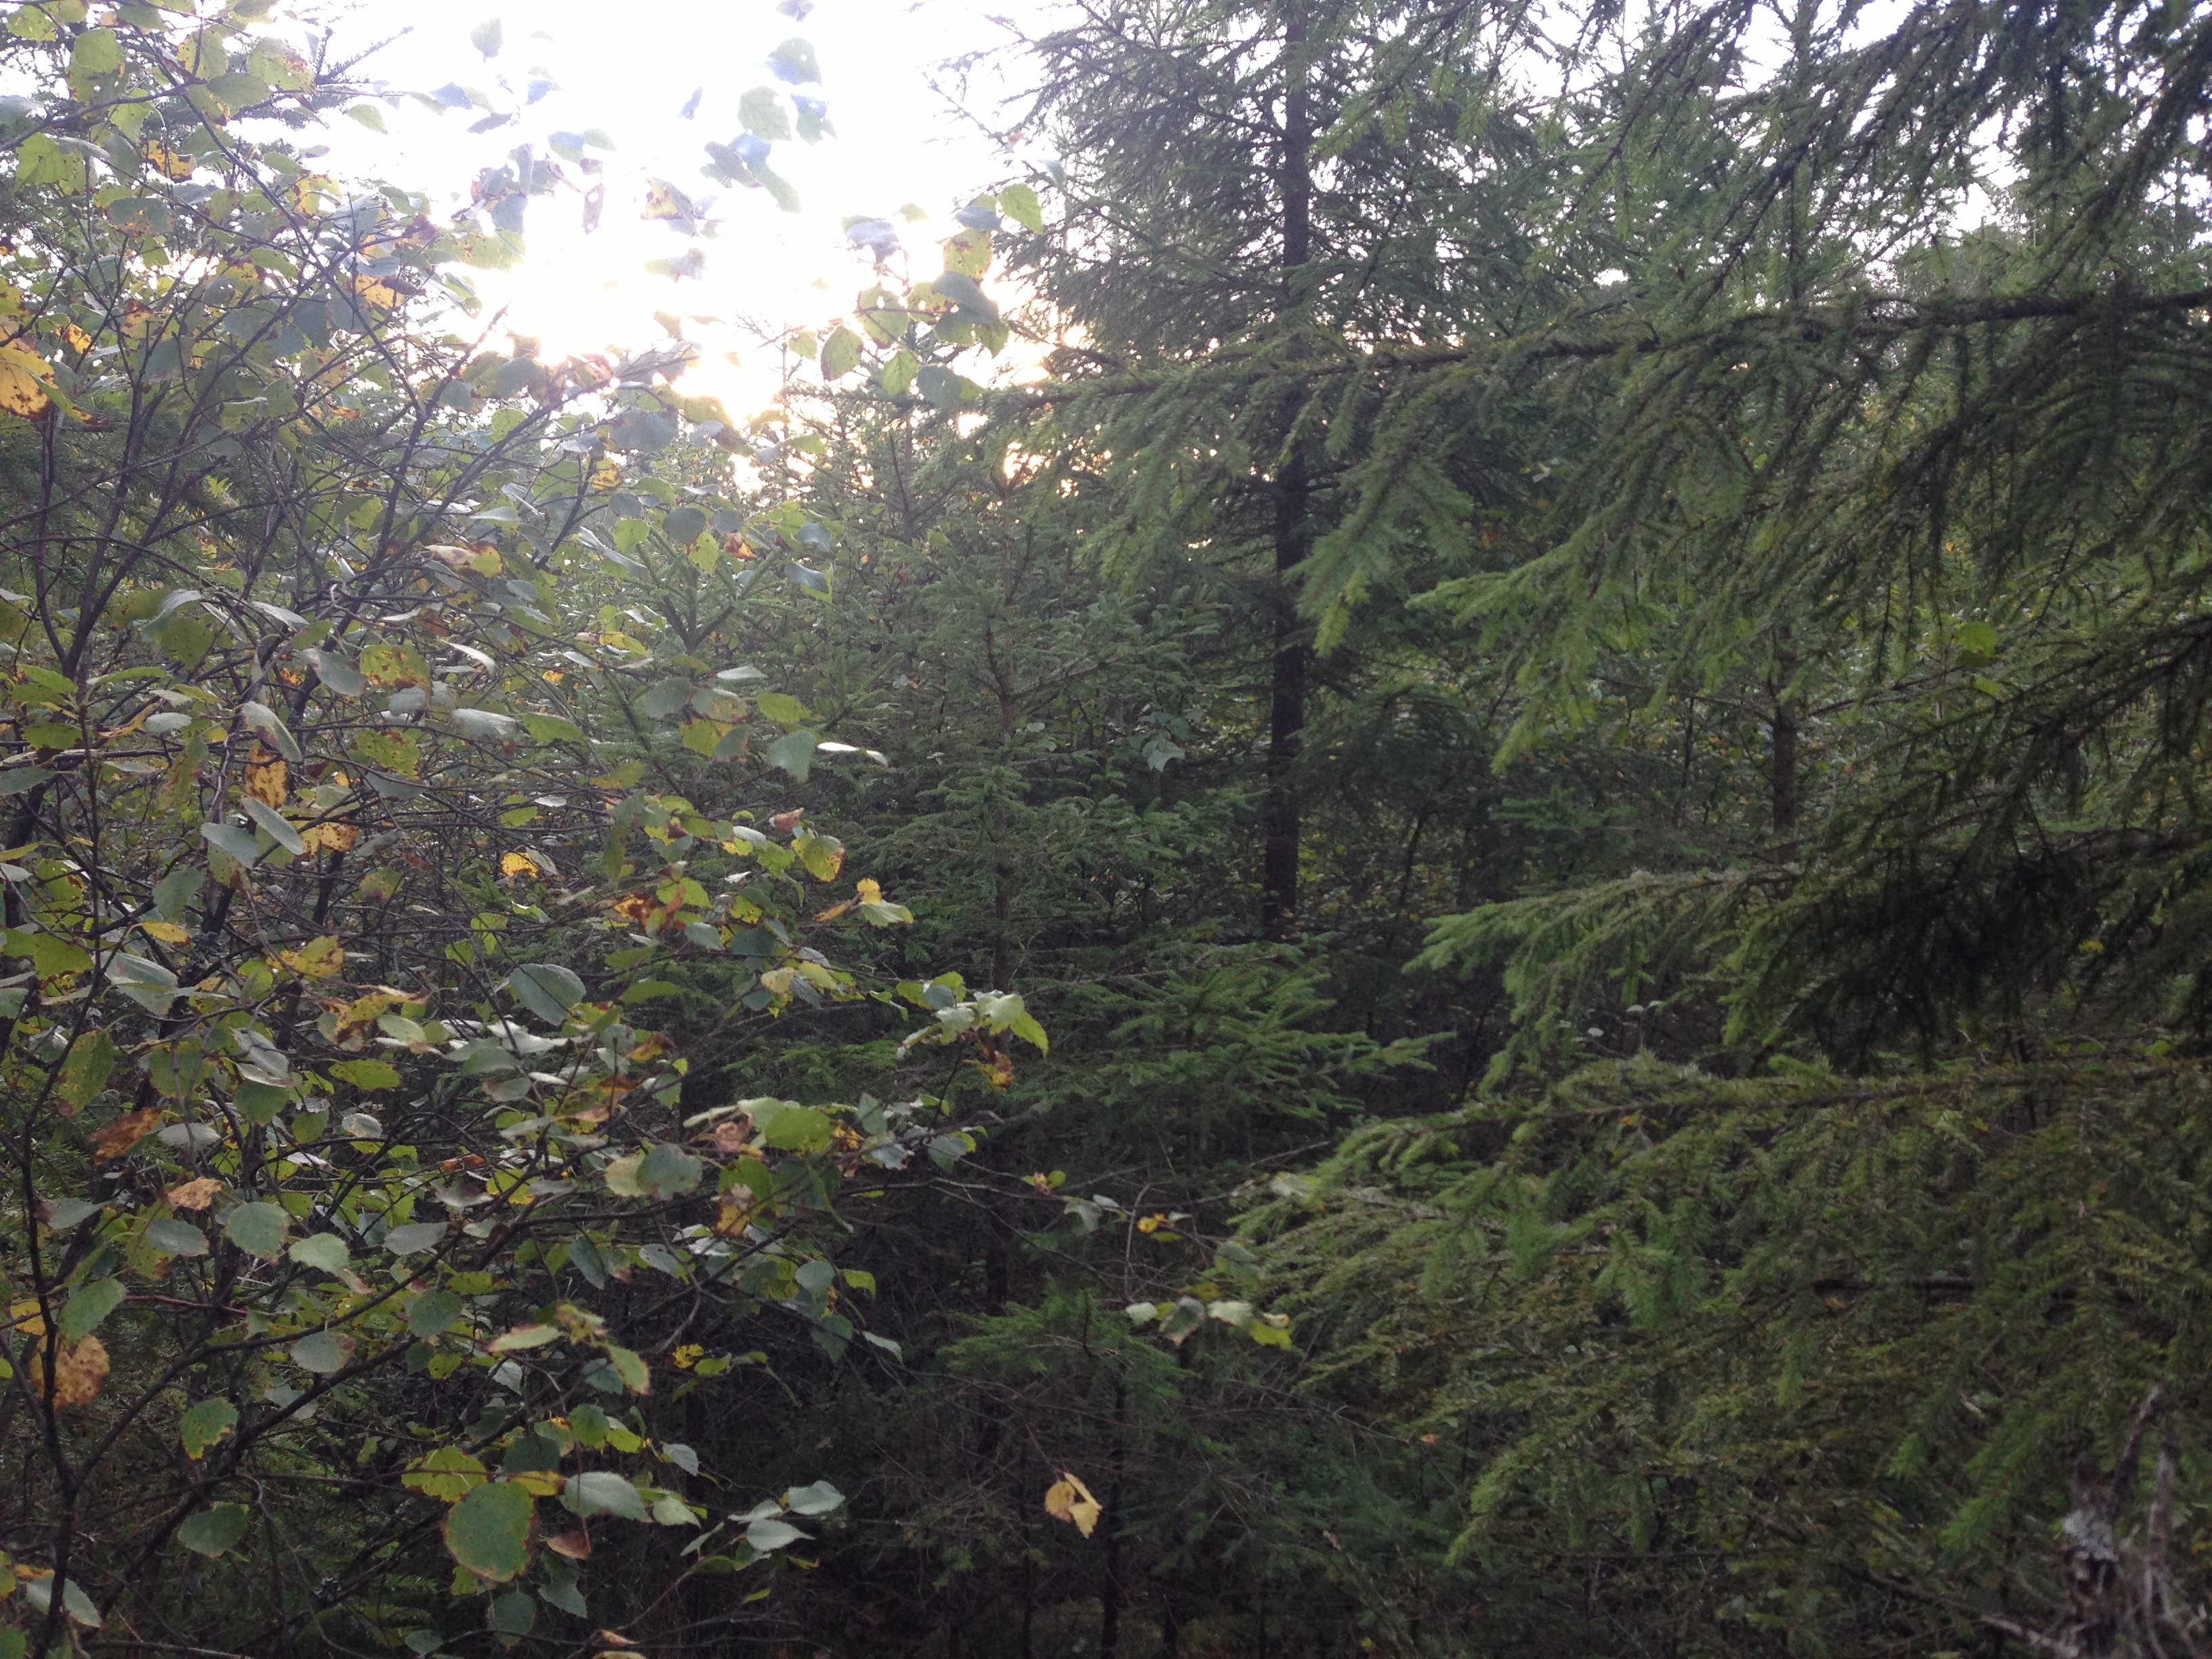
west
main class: Woodland
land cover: Spruce dominated mixed woodland
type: boreal forest
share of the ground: > 75 %
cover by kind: coniferous forest trees 60 %, broadleaved forest trees 20 %, shrubs 20 %
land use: Forestry
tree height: > 5 m
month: September
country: SE
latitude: 57.1207
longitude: 13.1508
